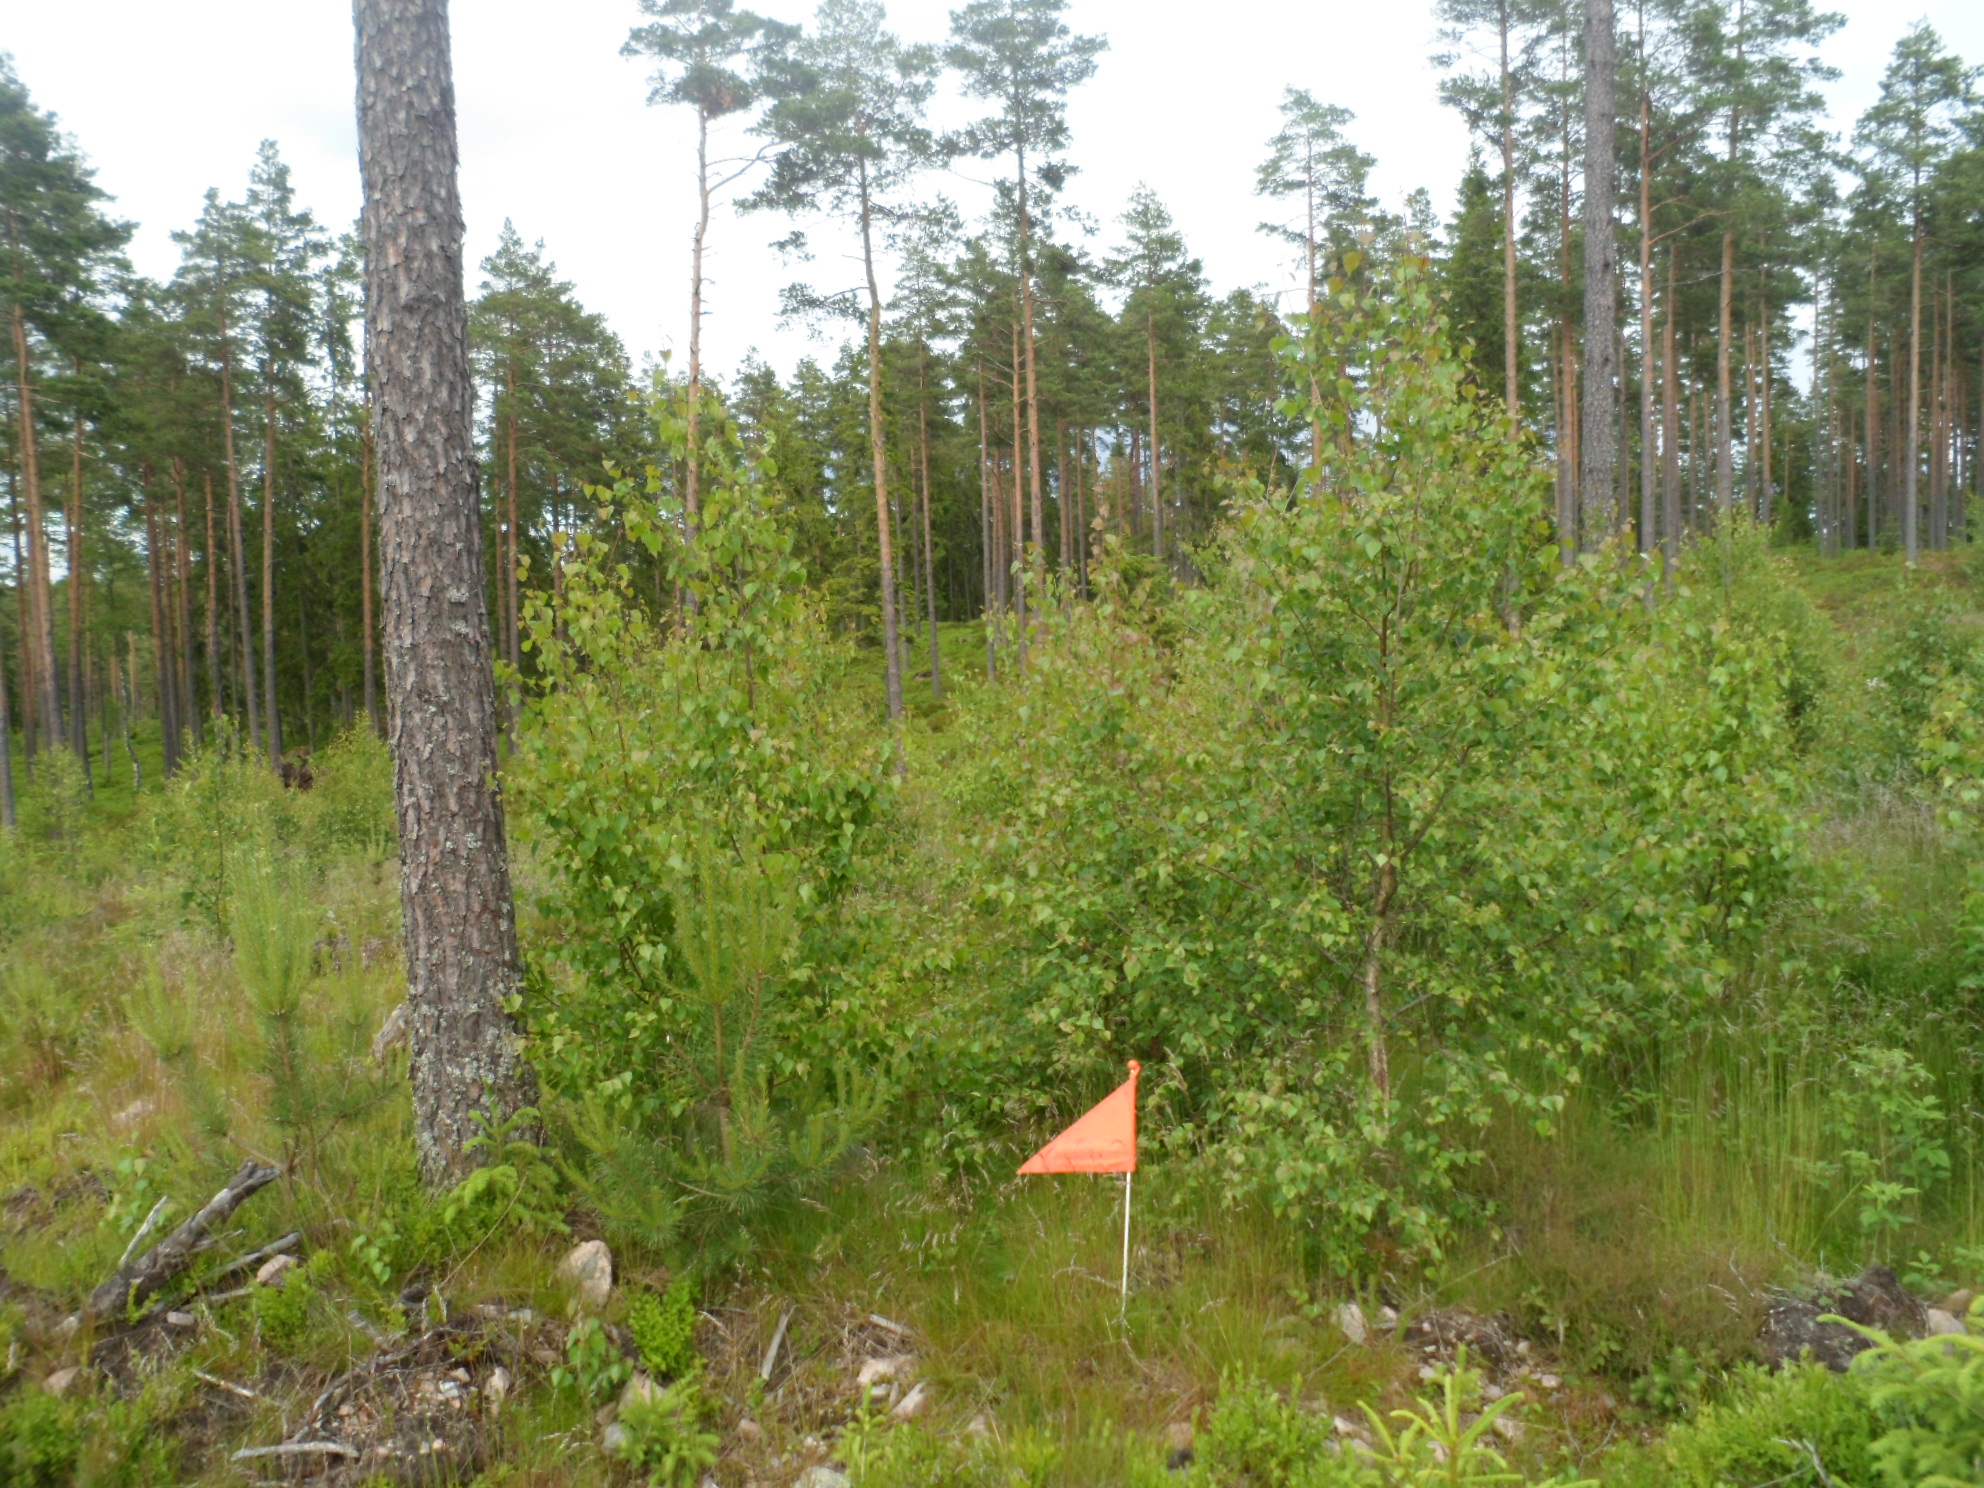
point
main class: Woodland
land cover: Pine dominated mixed woodland
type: boreal forest
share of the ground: 25 - 50 %
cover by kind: shrubs 30 %, herbaceous plants 25 %, coniferous forest trees 20 %, broadleaved forest trees 20 %, lichens and mosses 5 %
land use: Forestry
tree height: > 5 m
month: June
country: SE
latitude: 56.9928
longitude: 15.4130
